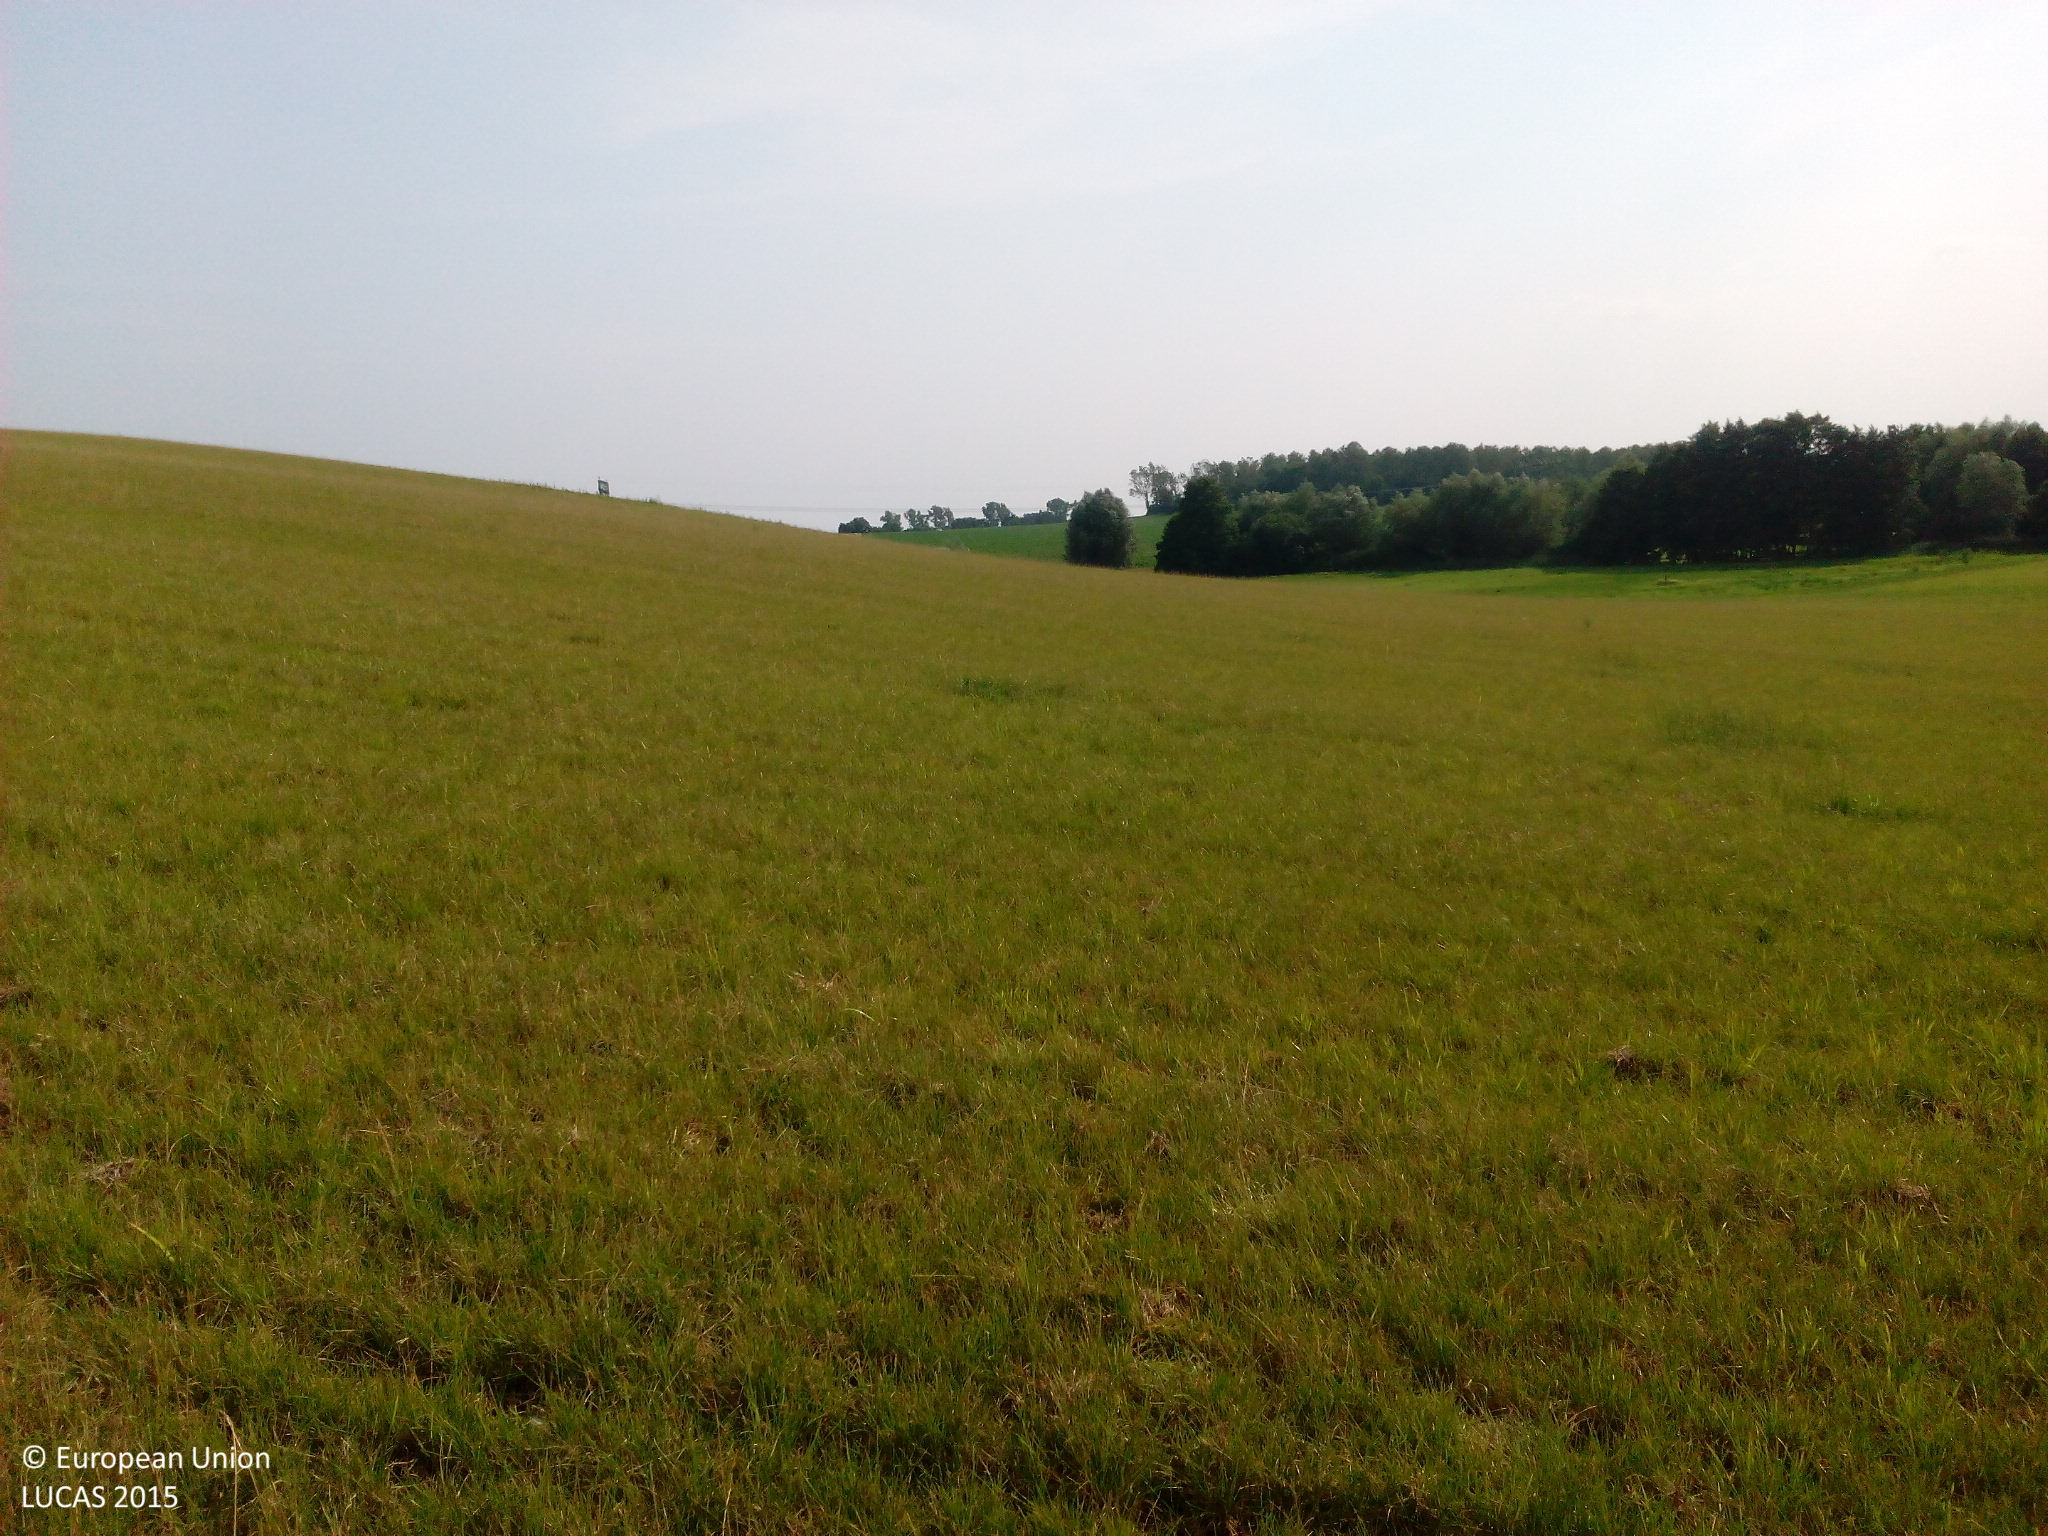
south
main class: Cropland
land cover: Temporary grasslands
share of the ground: > 75 %
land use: Agriculture (excluding fallow land and kitchen gardens)
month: August
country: DE
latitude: 53.4674
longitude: 13.2082
